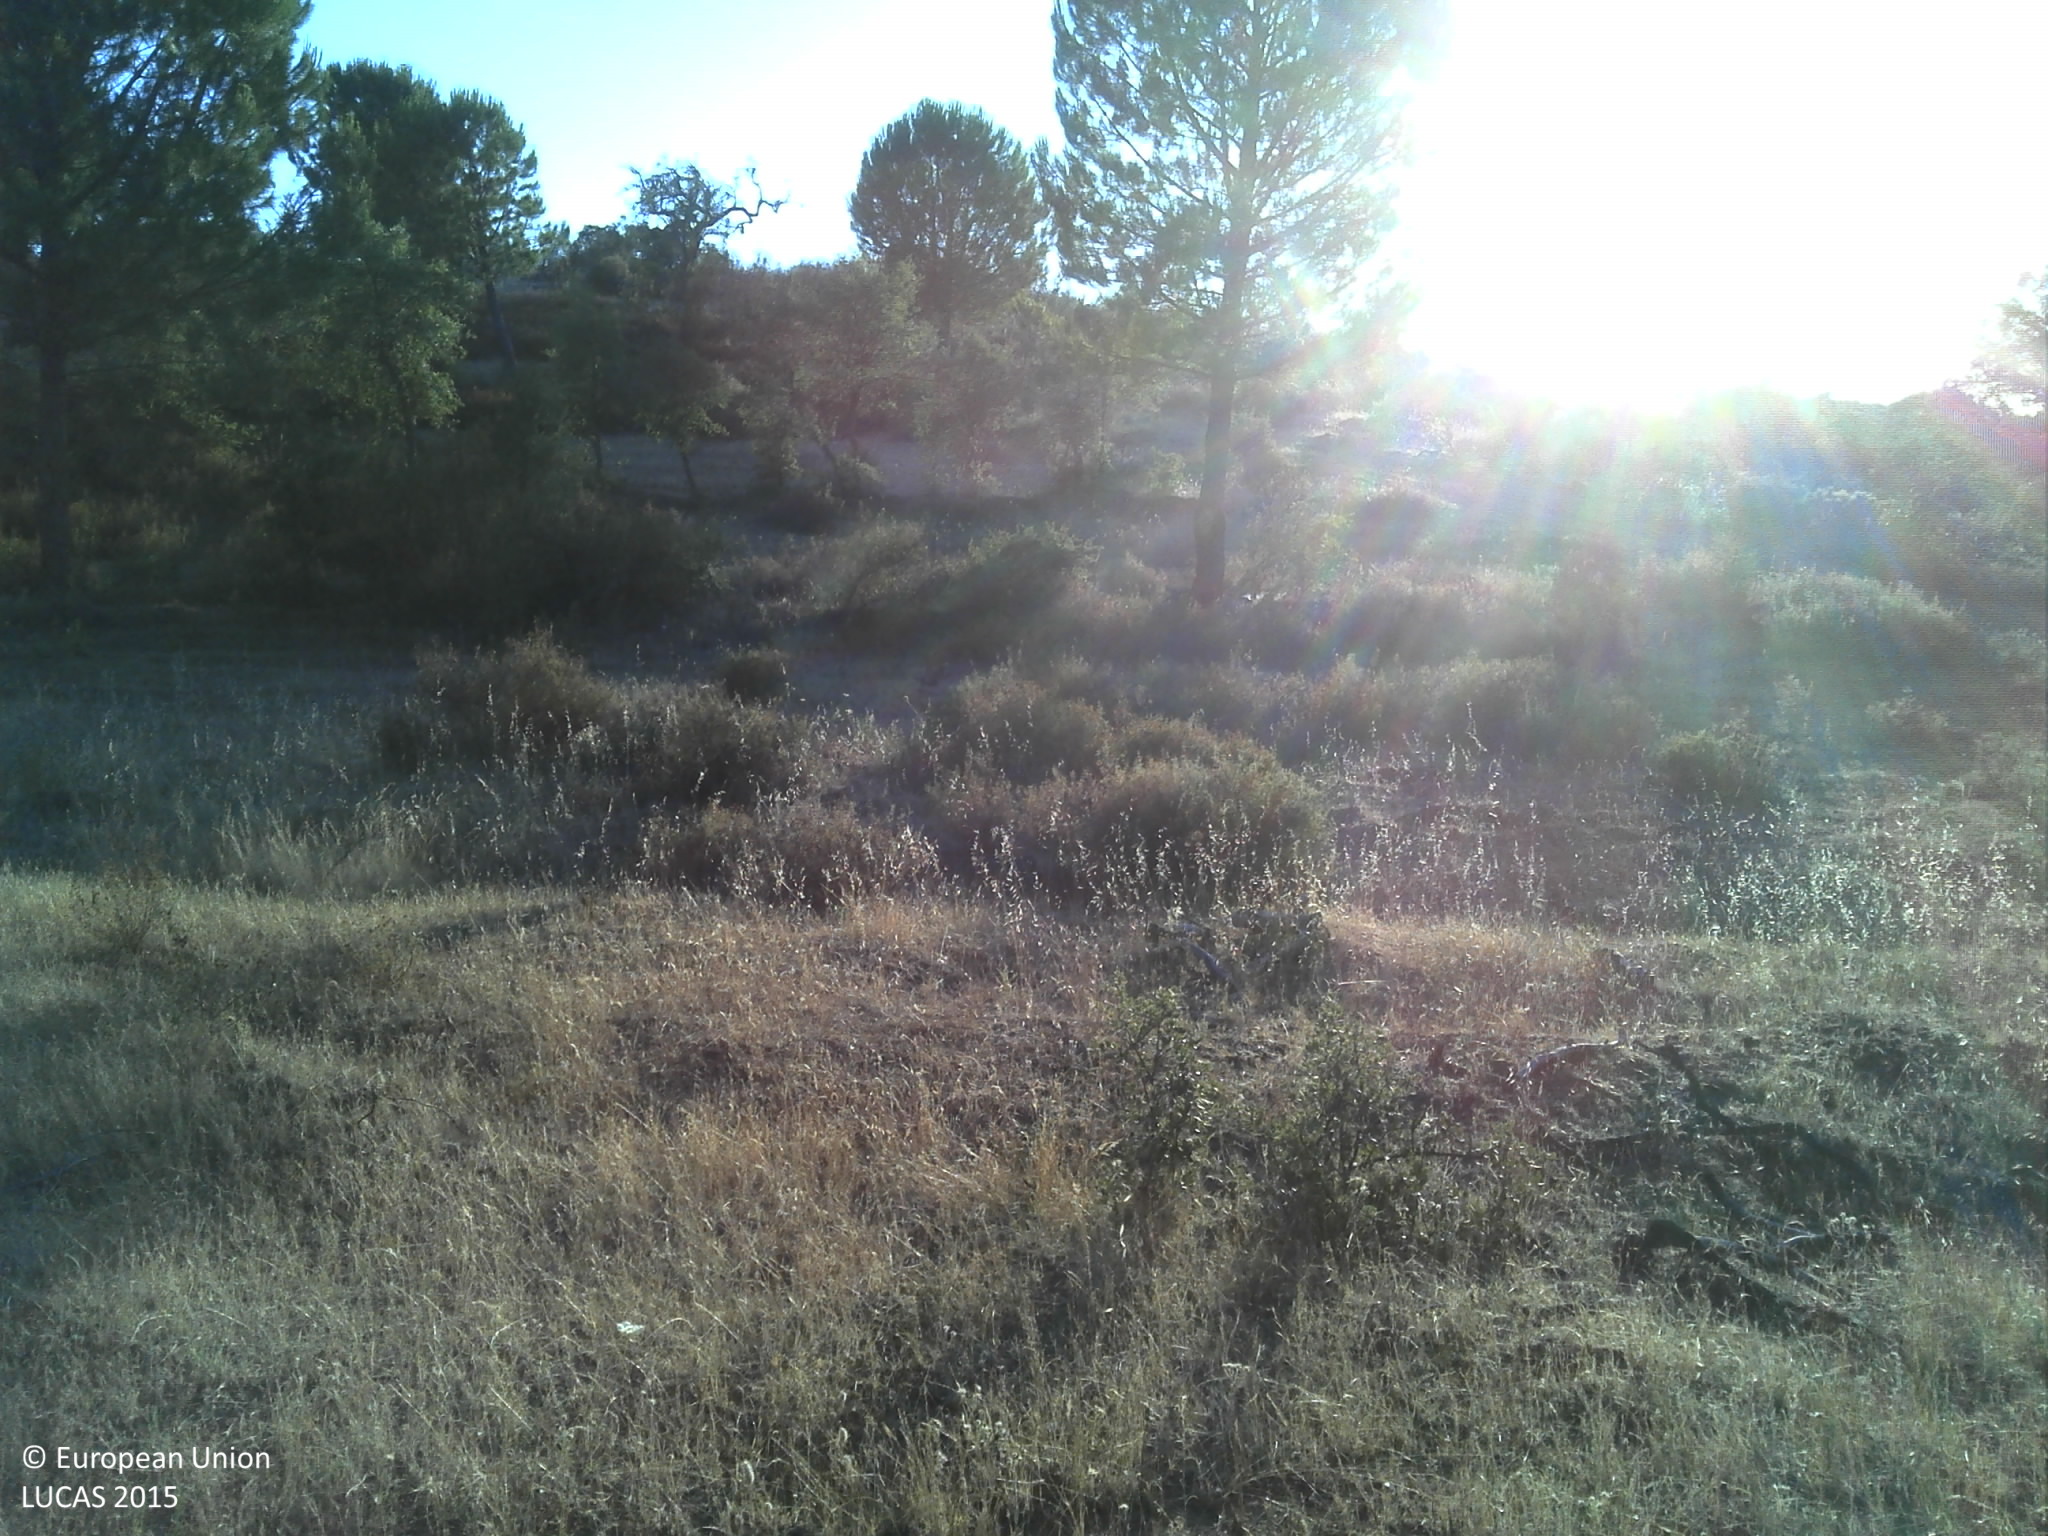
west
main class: Woodland
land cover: Other mixed woodland
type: broadleaved evergreen forest
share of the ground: 50 - 75 %
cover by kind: broadleaved forest trees 50 %, coniferous forest trees 35 %, herbaceous plants 15 %
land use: Forestry
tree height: > 5 m
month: June
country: PT
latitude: 38.0722
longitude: -7.1924
